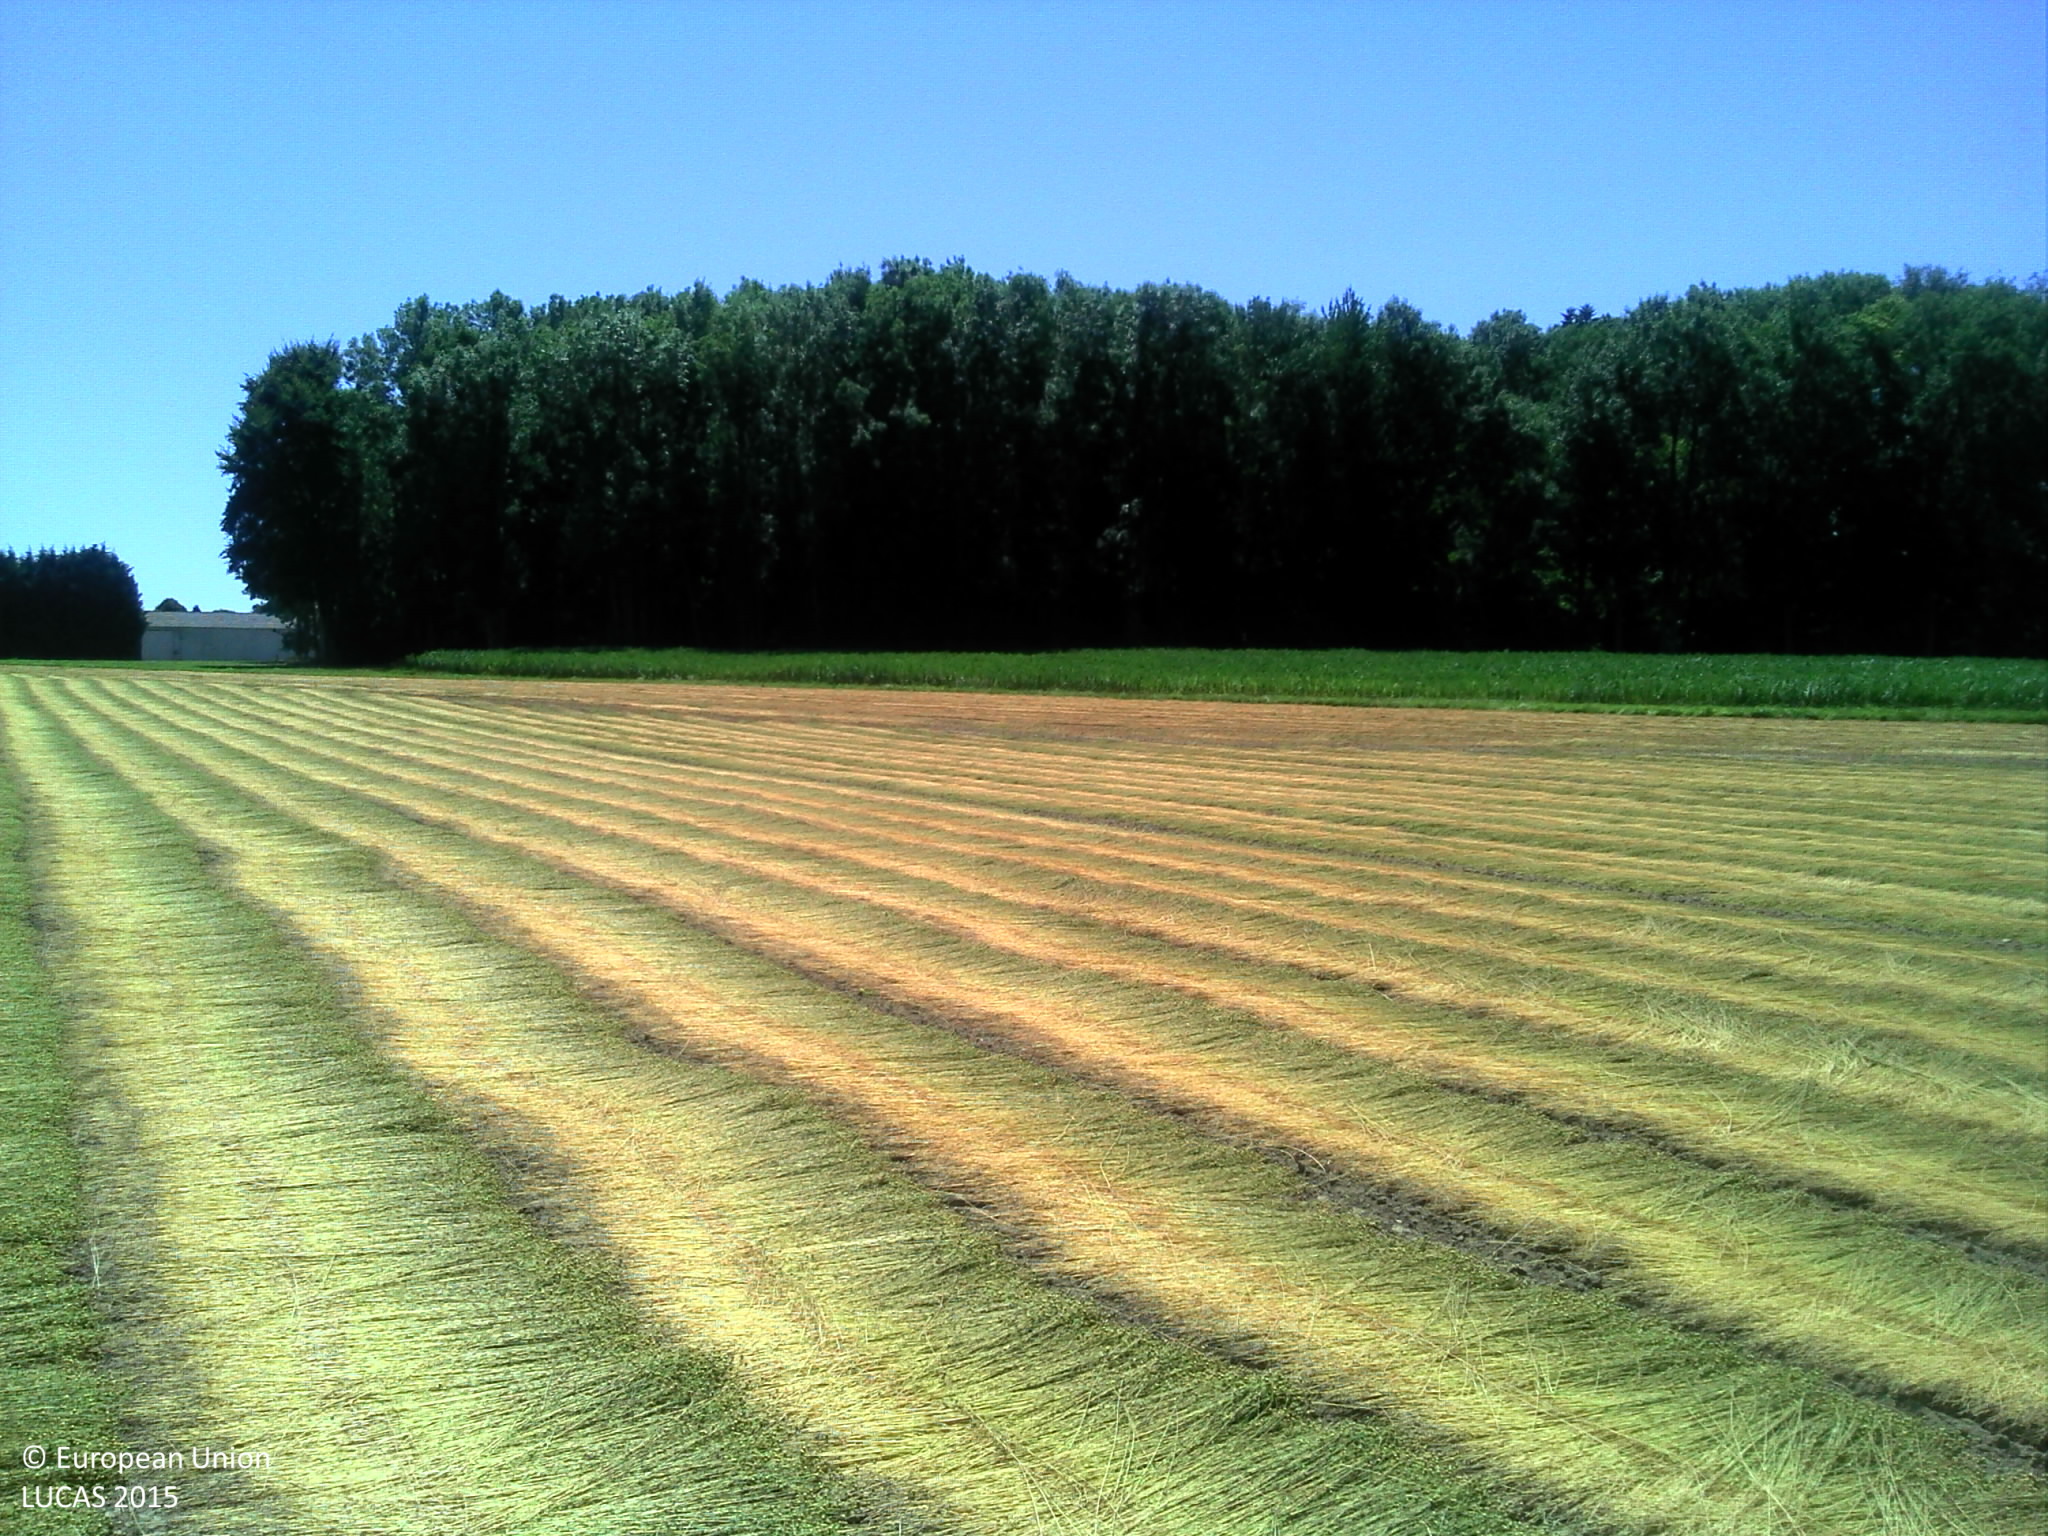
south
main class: Cropland
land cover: Other fibre and oleaginous crops
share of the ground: 25 - 50 %
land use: Agriculture (excluding fallow land and kitchen gardens)
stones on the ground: < 10 %
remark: Harvested field
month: July
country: FR
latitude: 49.0793
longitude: 0.4862
